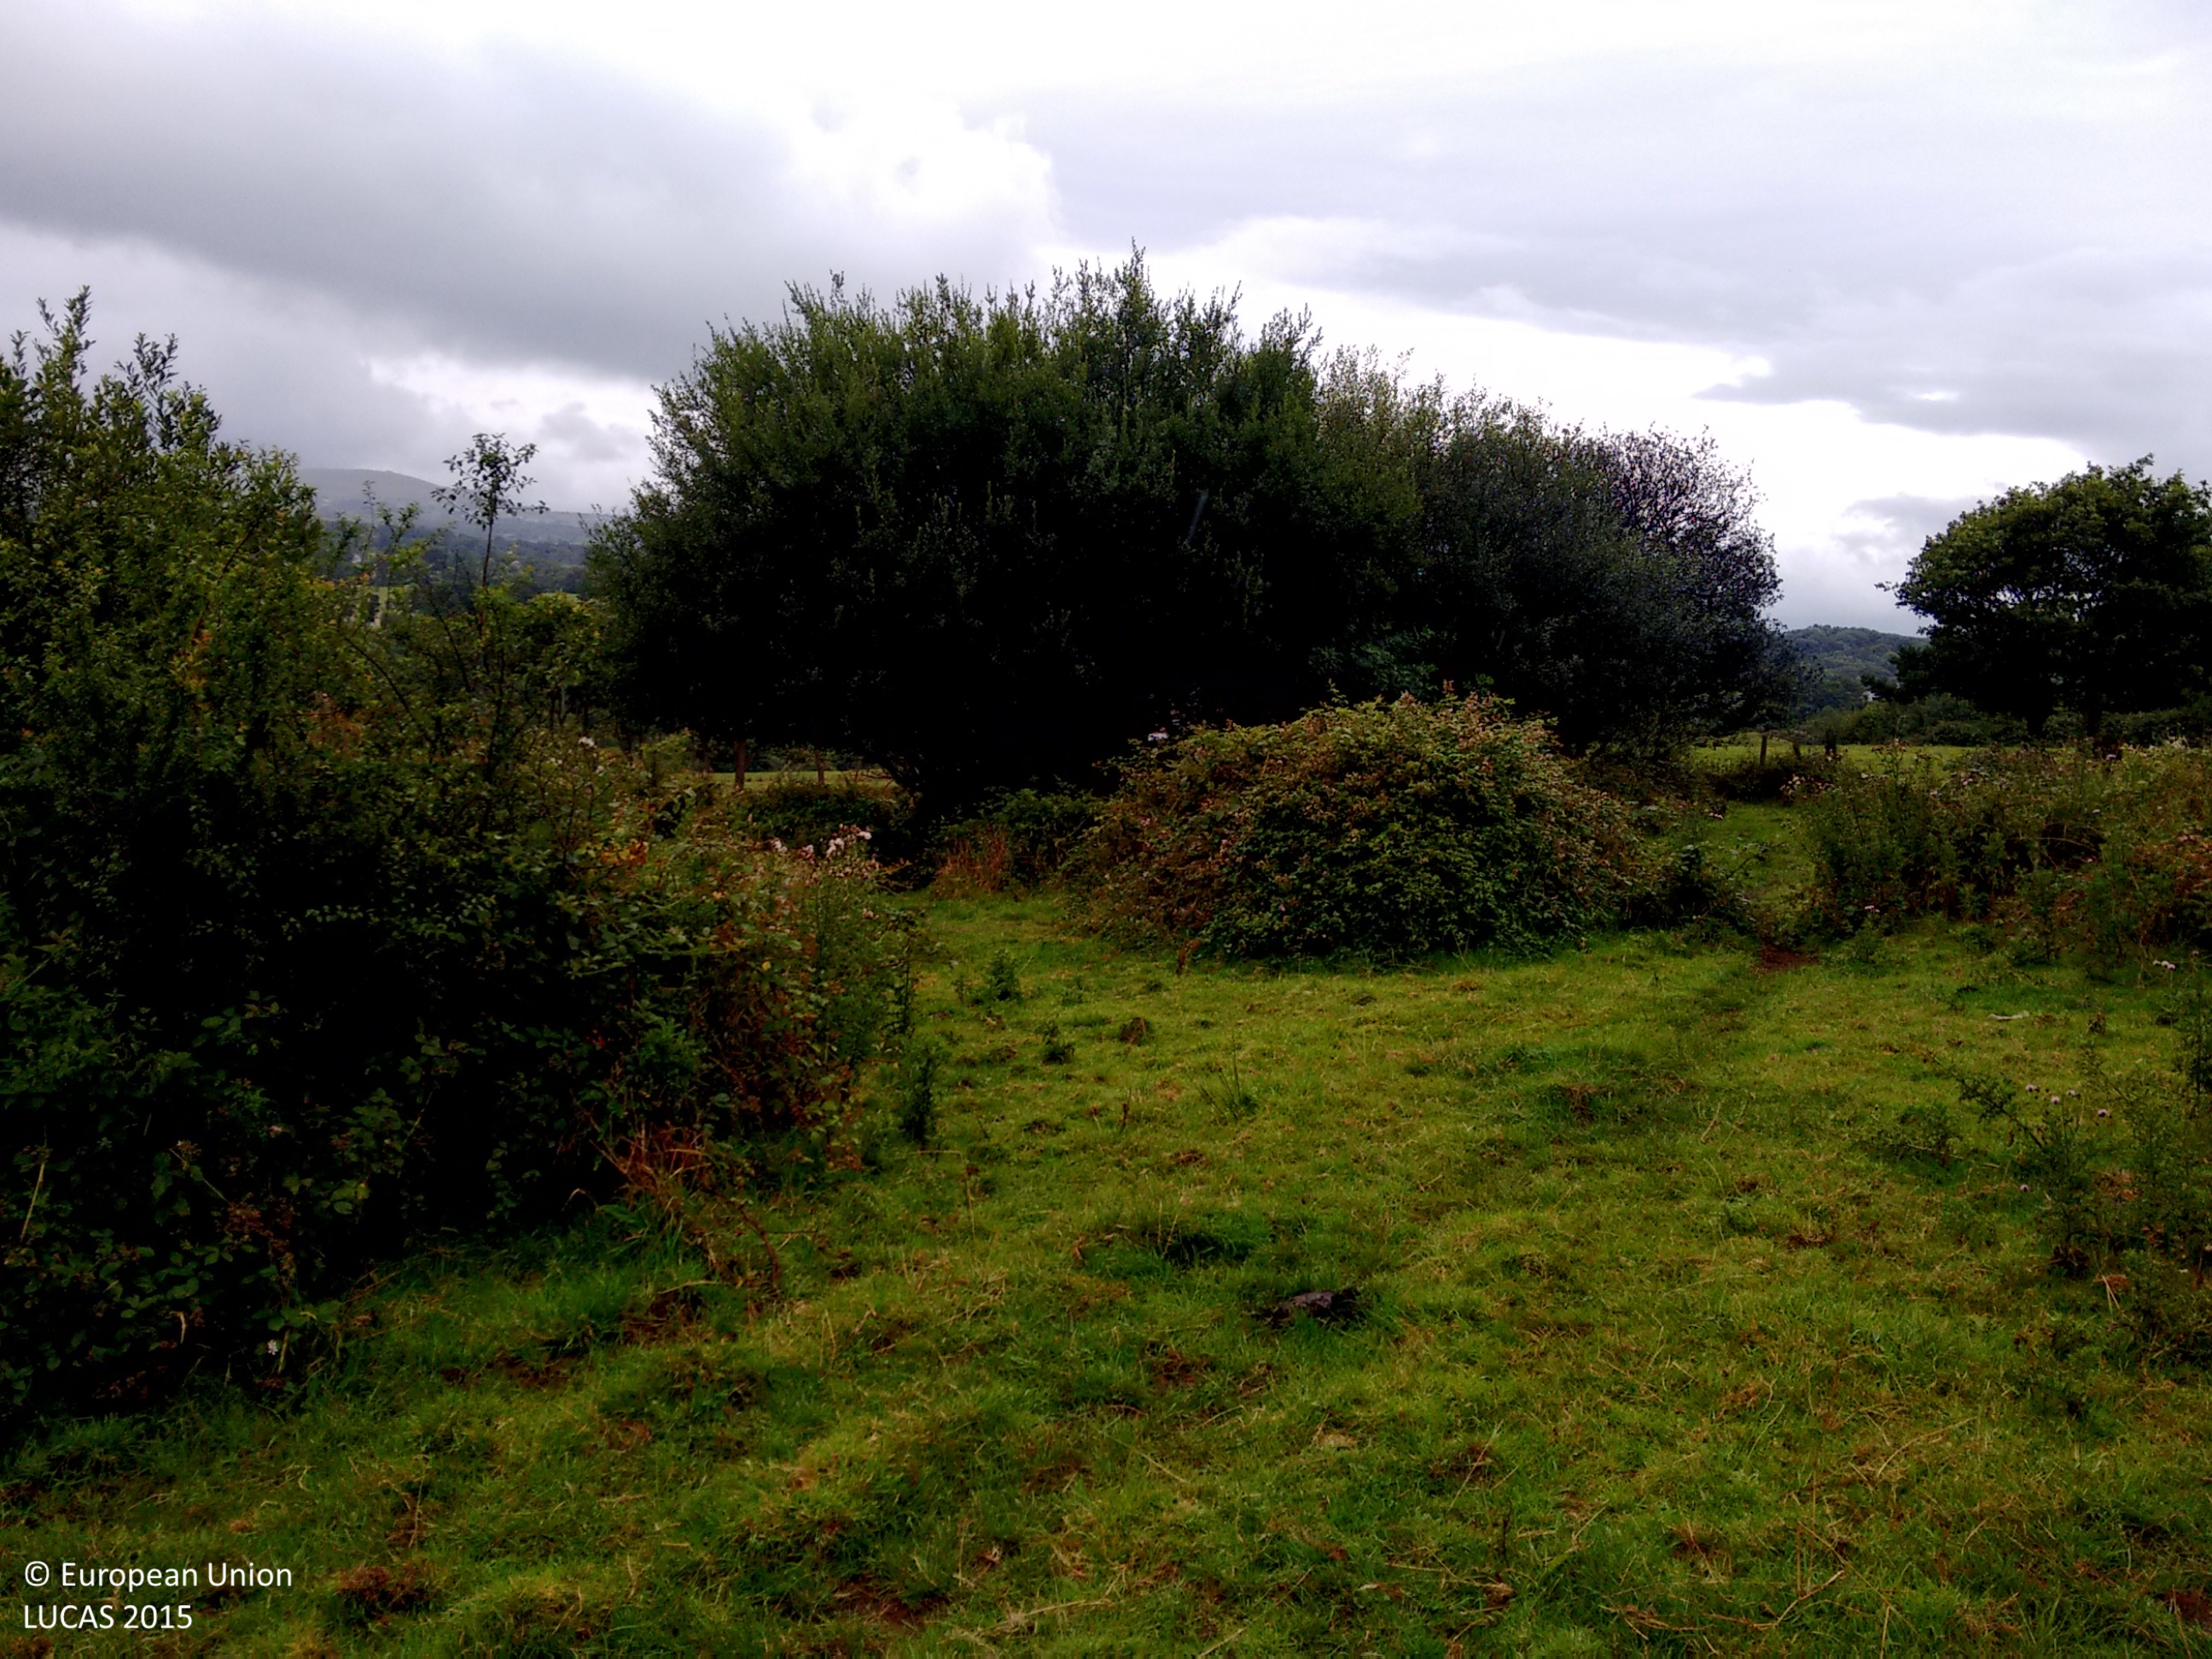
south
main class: Shrubland
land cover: Shrubland with sparse tree cover
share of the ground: > 75 %
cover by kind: shrubs 95 %, broadleaved forest trees 5 %
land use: Agriculture (excluding fallow land and kitchen gardens)
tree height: < 5 m
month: August
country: GB
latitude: 53.1373
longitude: -4.2555
